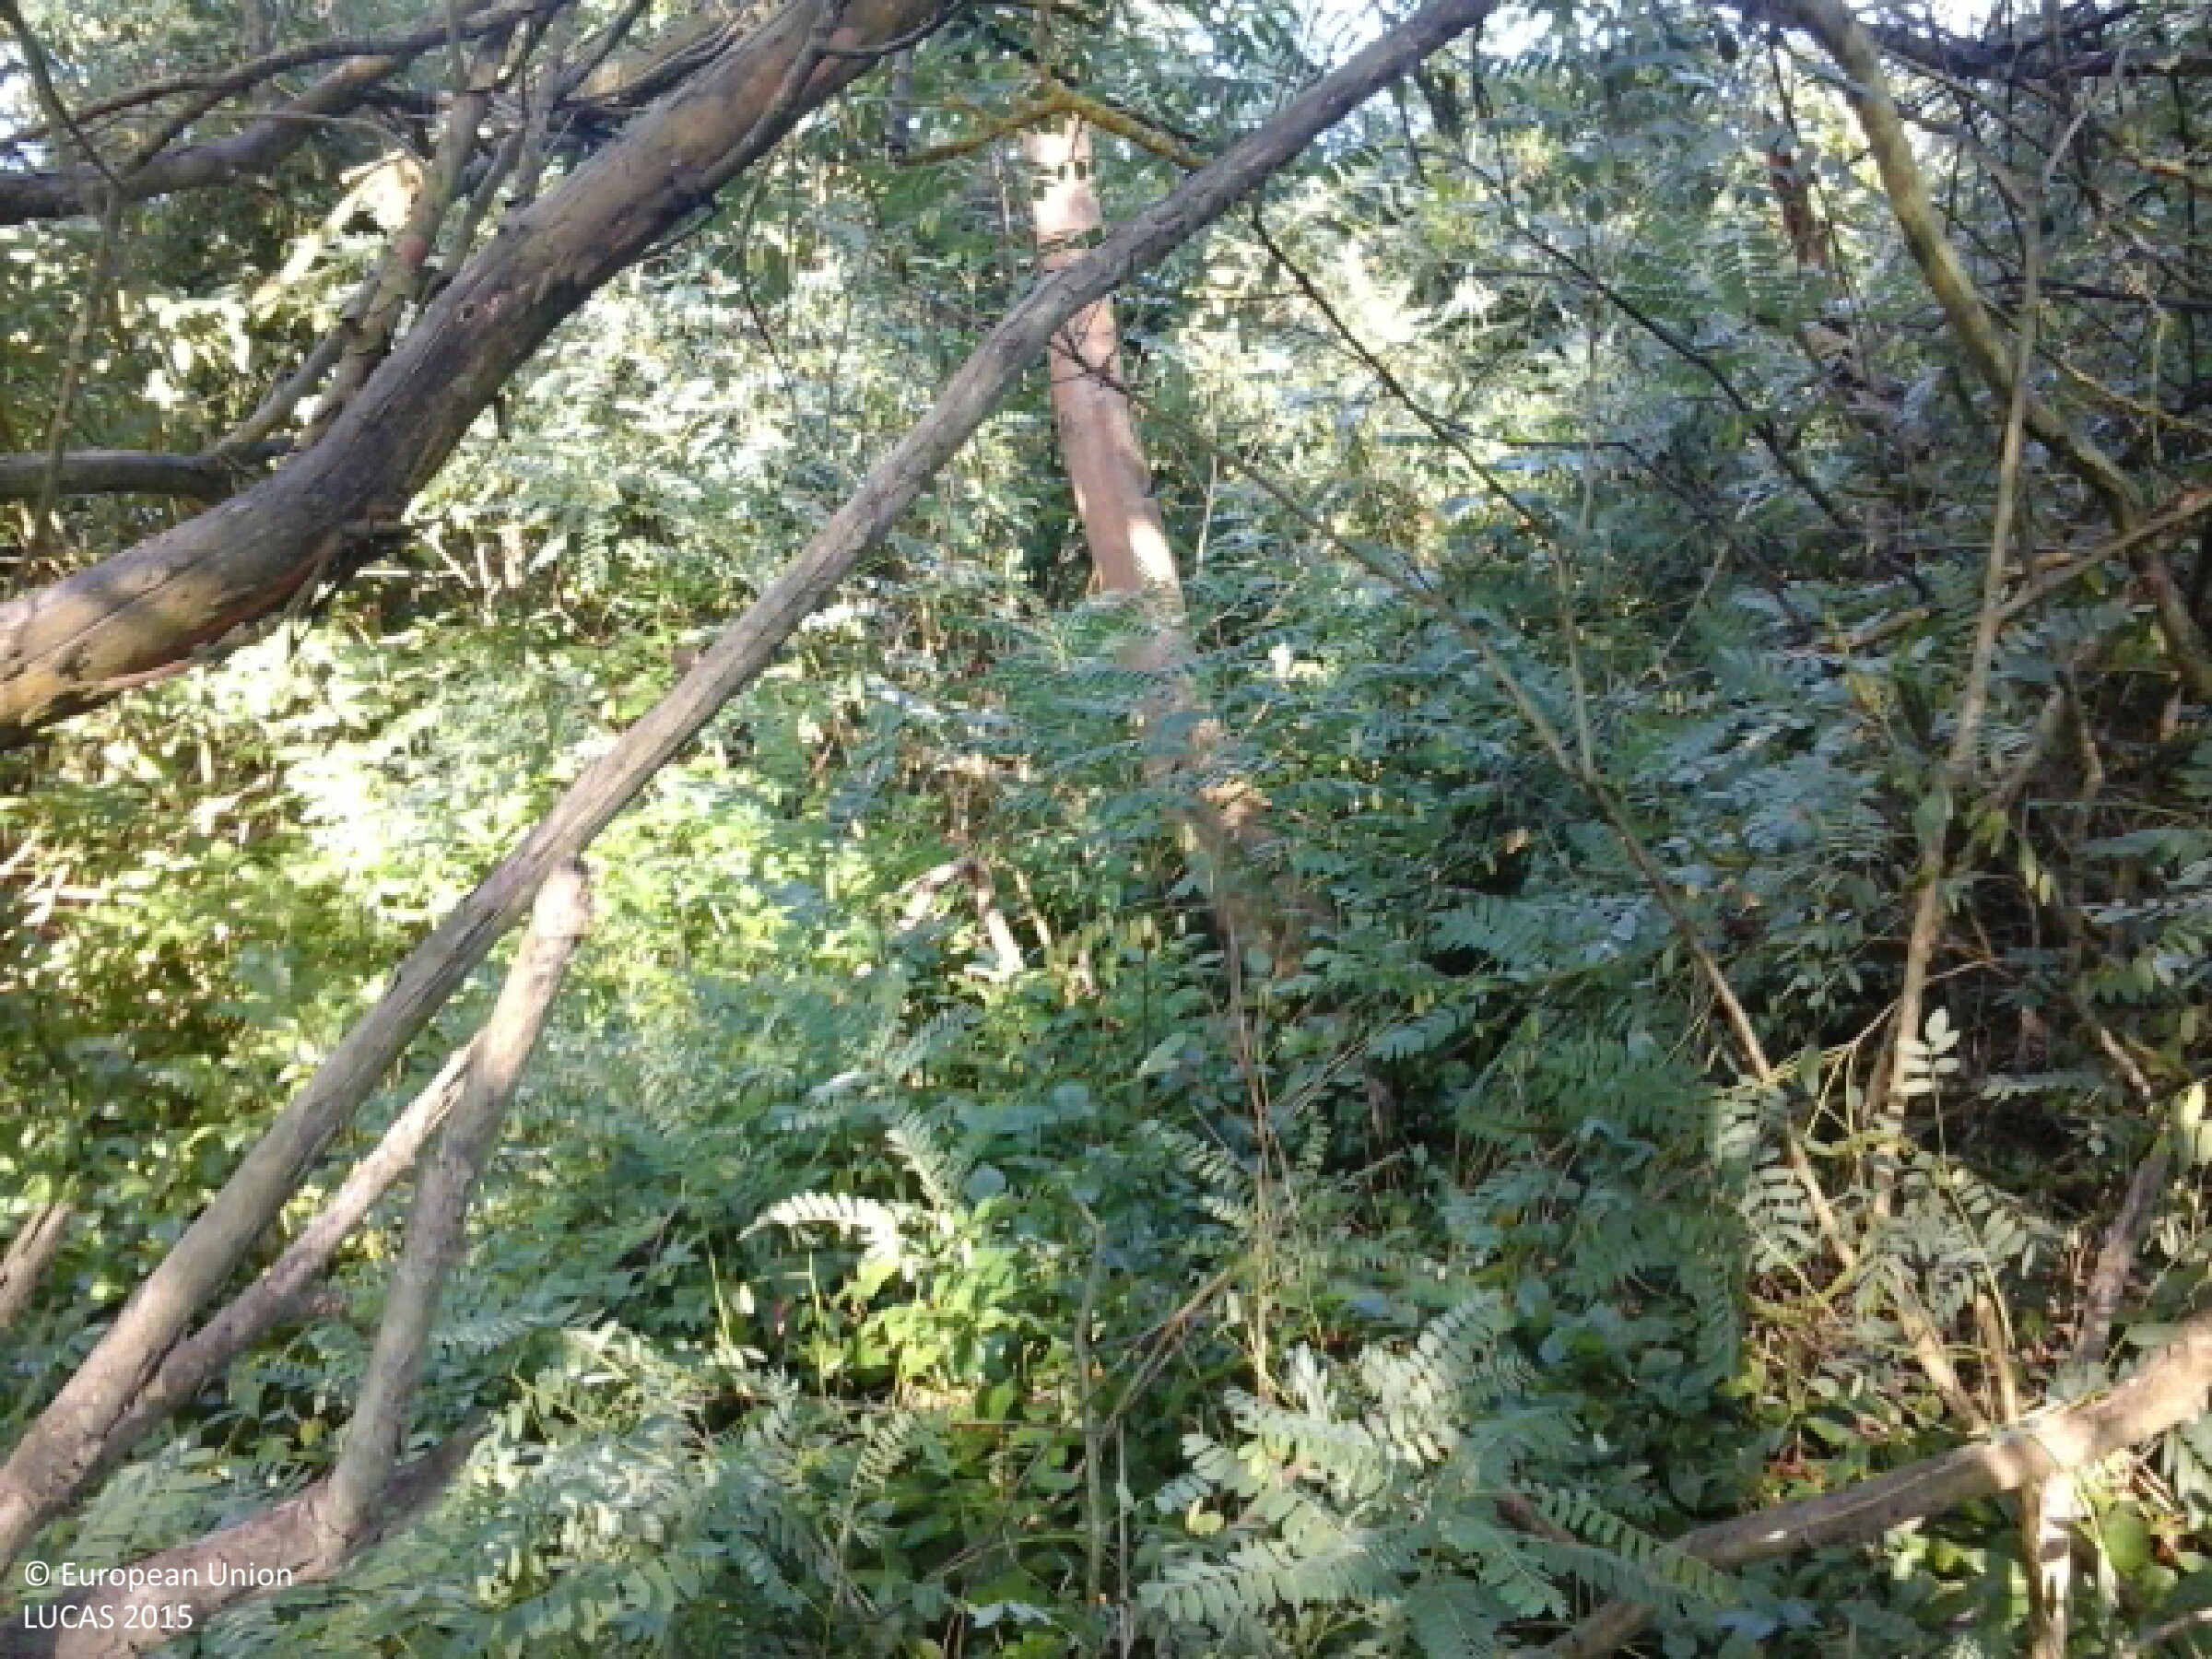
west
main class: Woodland
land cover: Broadleaved woodland
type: mesophytic deciduous forest
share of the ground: > 75 %
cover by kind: broadleaved forest trees 95 %, herbaceous plants 5 %
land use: Forestry
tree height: > 5 m
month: July
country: HU
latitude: 48.3527
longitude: 21.6130
